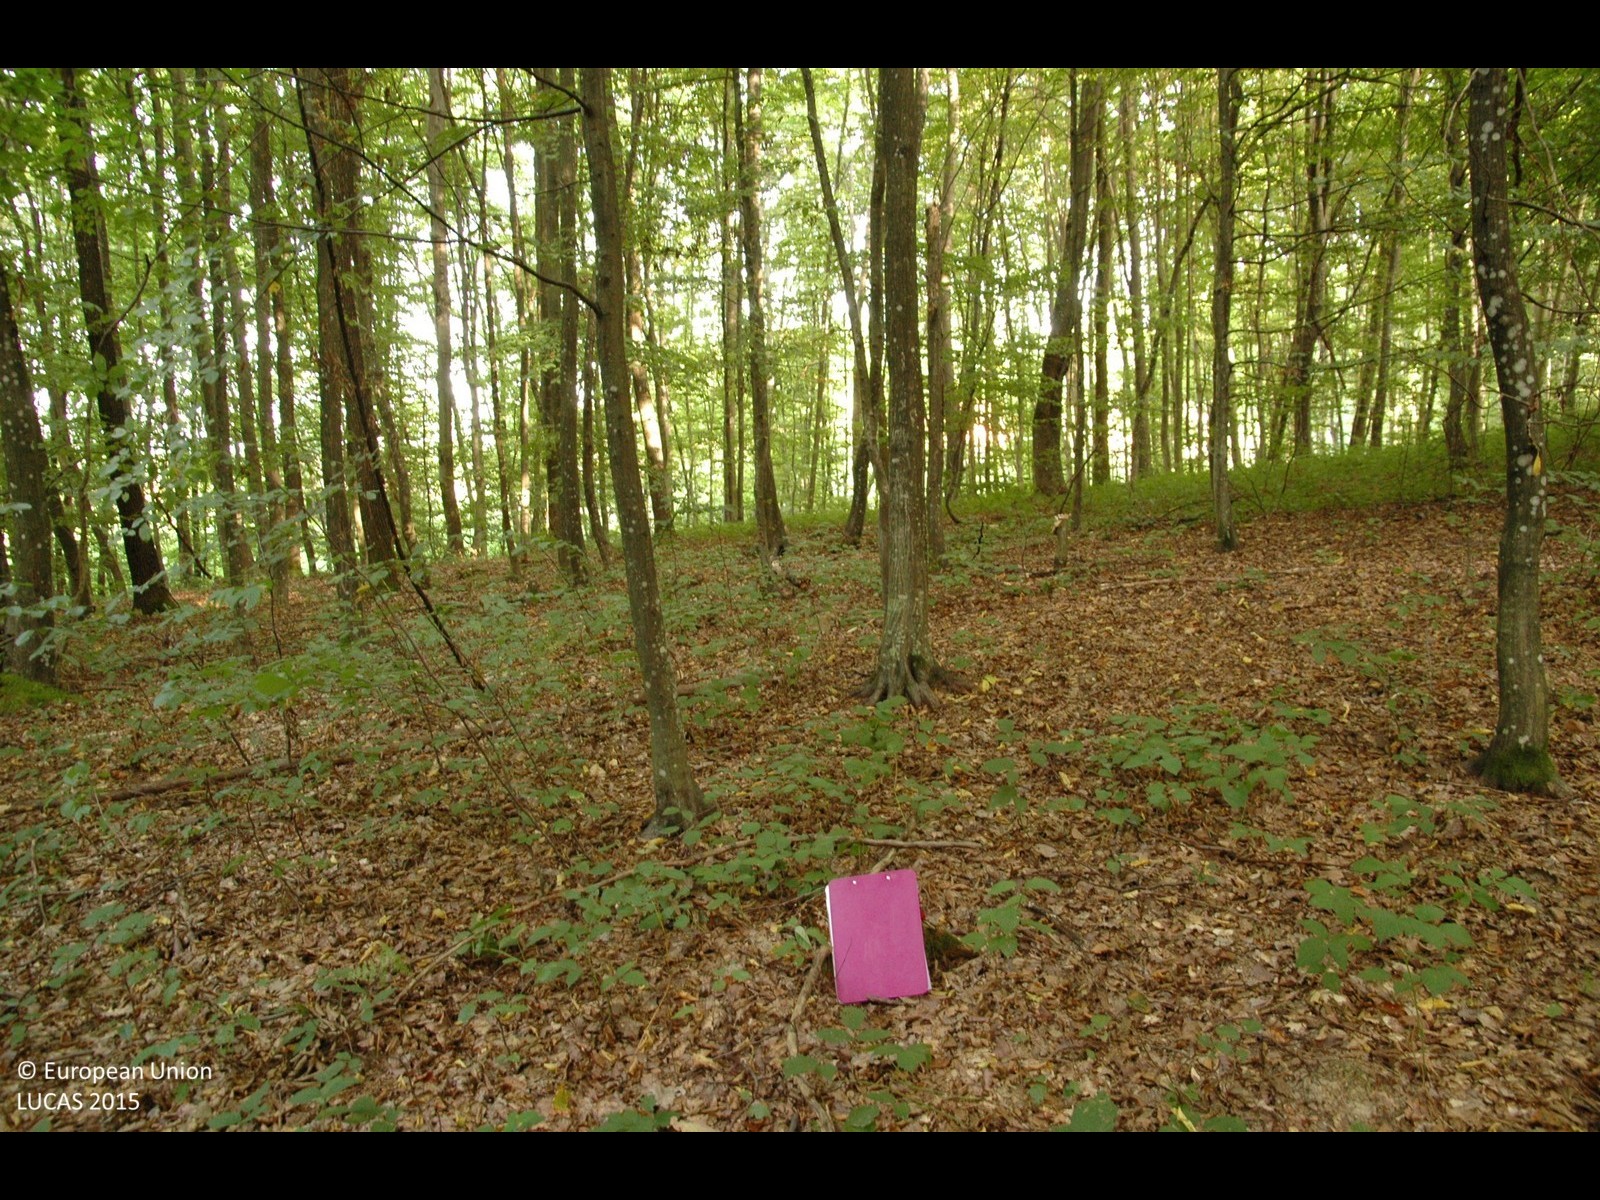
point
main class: Woodland
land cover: Broadleaved woodland
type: beech forest
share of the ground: > 75 %
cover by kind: broadleaved forest trees 100 %
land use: Forestry
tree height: > 5 m
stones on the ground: < 10 %
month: September
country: HR
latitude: 45.6638
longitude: 15.9142
